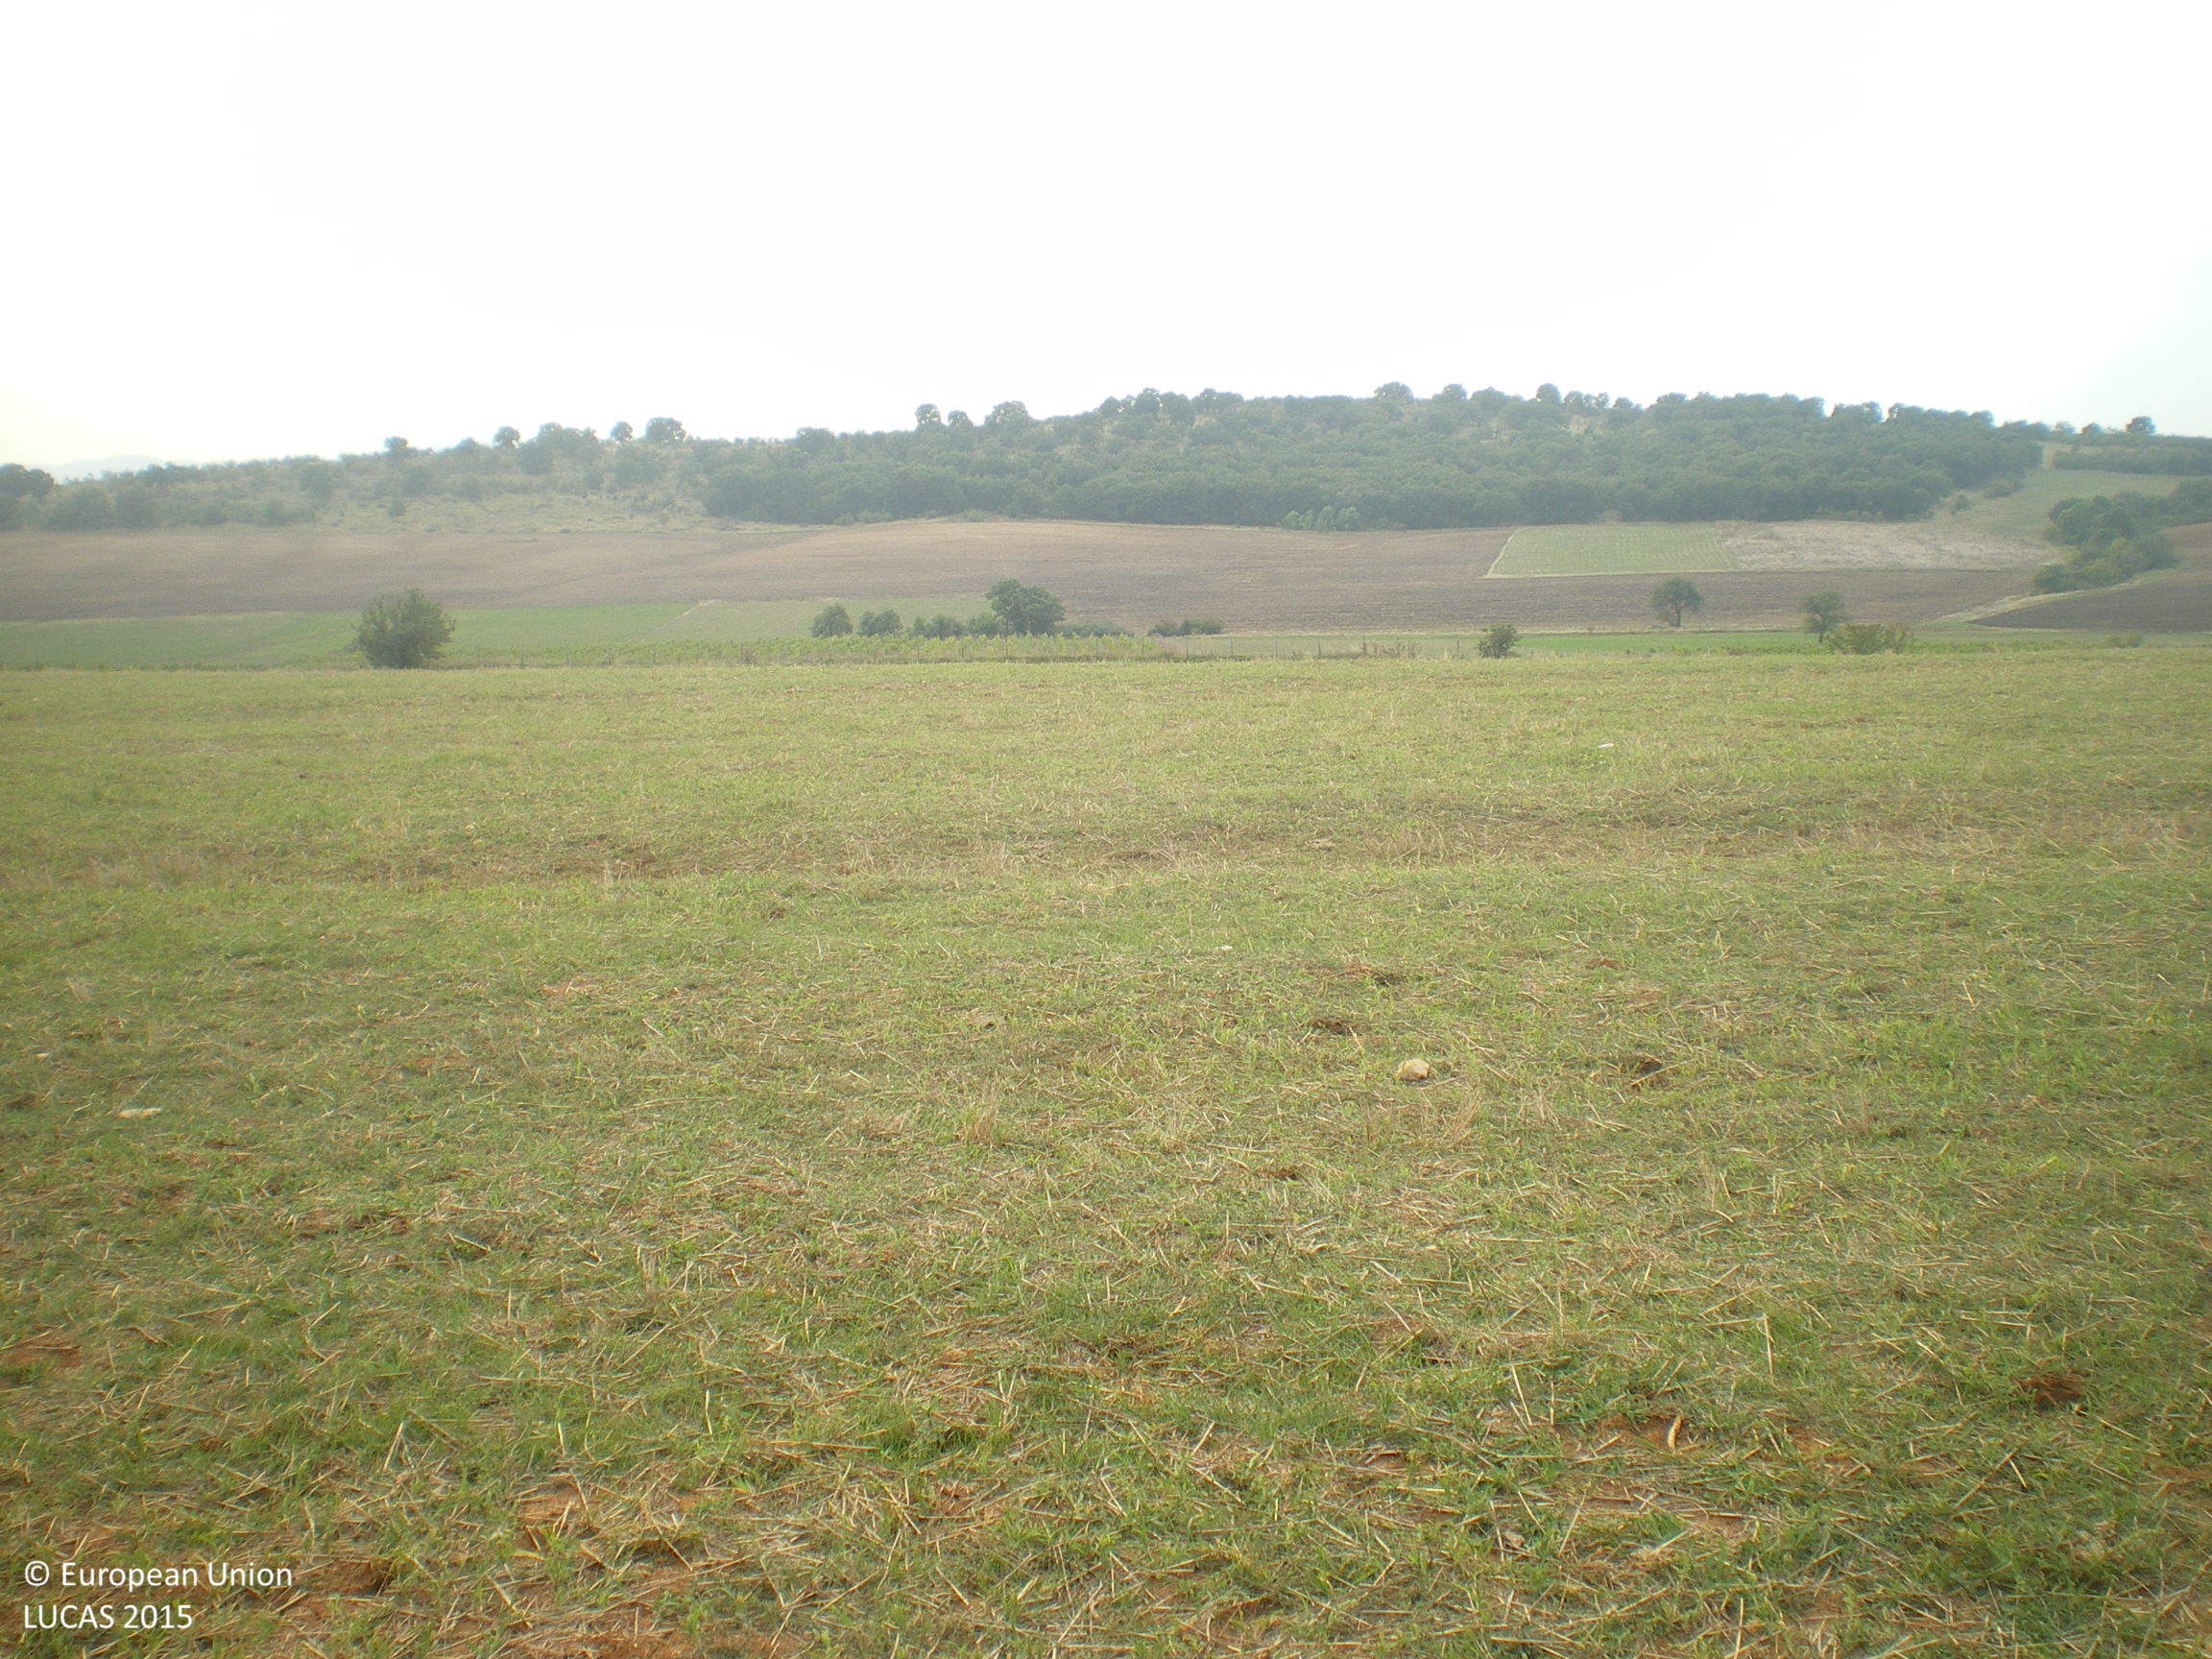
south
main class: Cropland
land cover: Common wheat
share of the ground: < 10 %
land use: Agriculture (excluding fallow land and kitchen gardens)
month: September
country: BG
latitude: 41.8819
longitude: 25.9176
